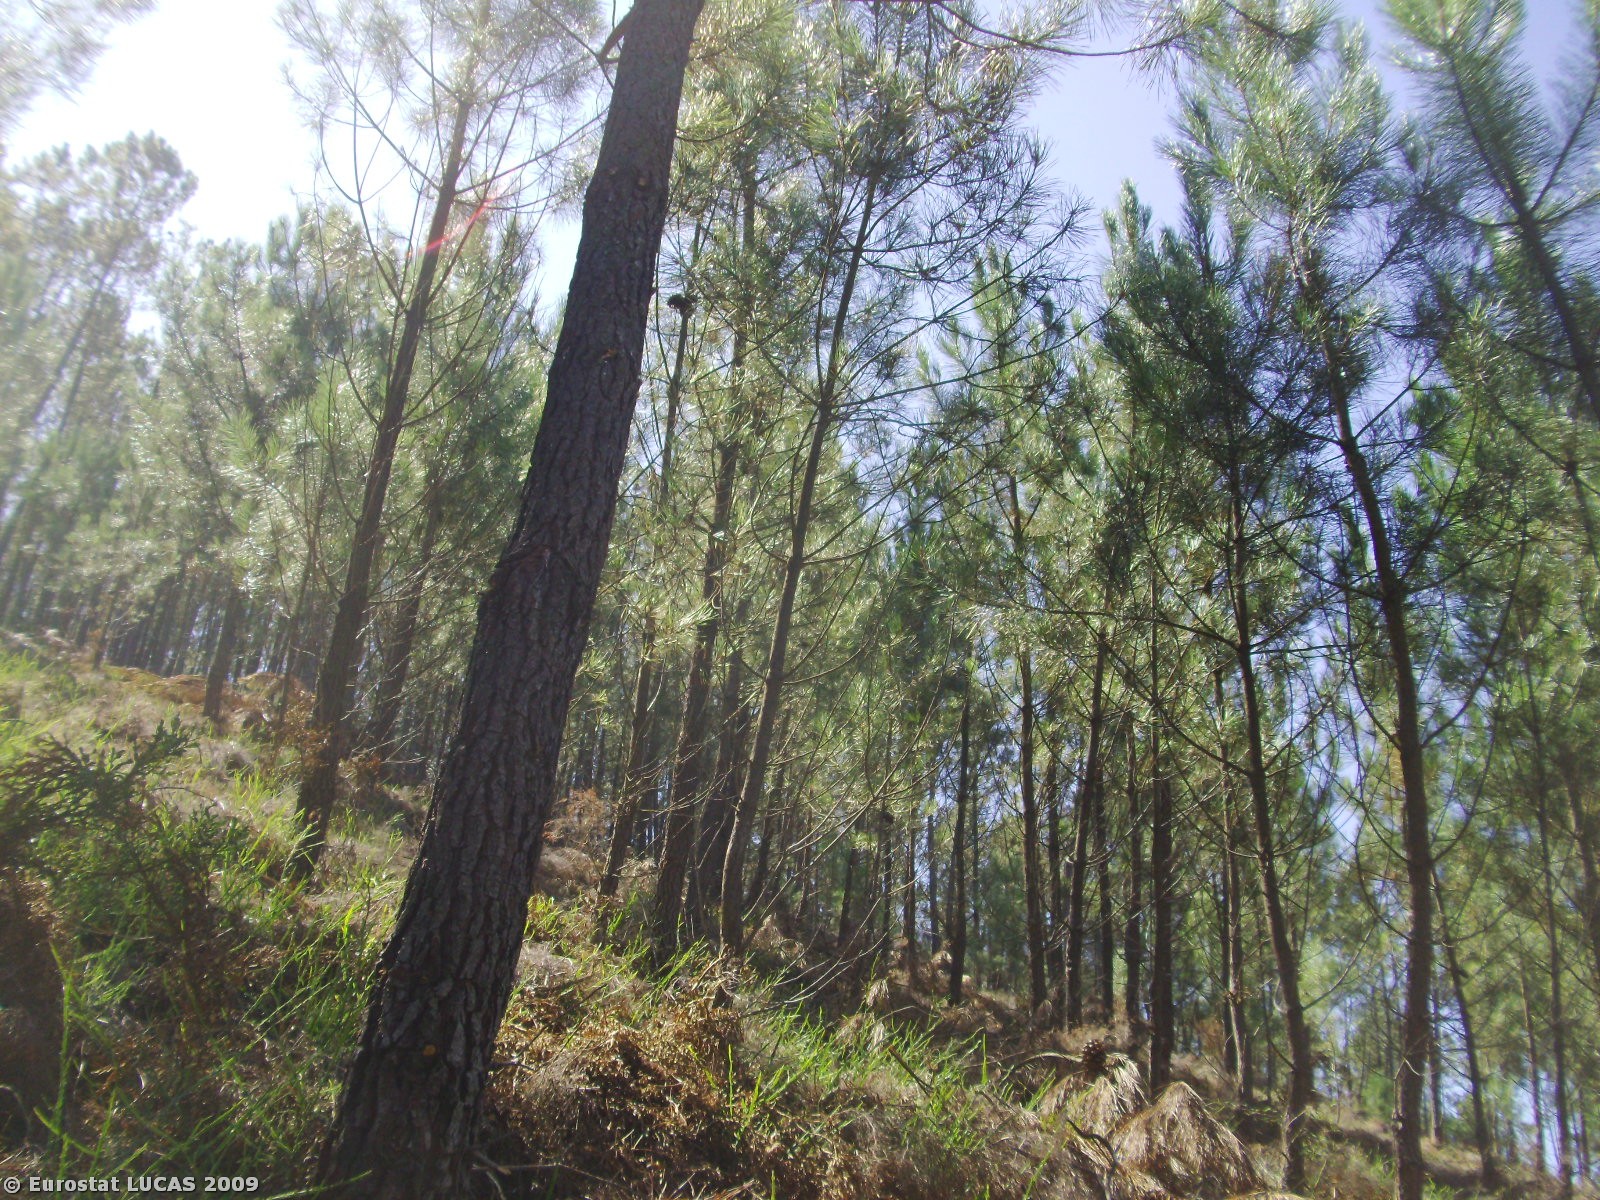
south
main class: Woodland
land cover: Coniferous woodland
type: coniferous forest of the mediterranean region
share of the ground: > 75 %
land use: Forestry
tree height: > 5 m
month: August
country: PT
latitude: 41.3517
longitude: -7.9334
